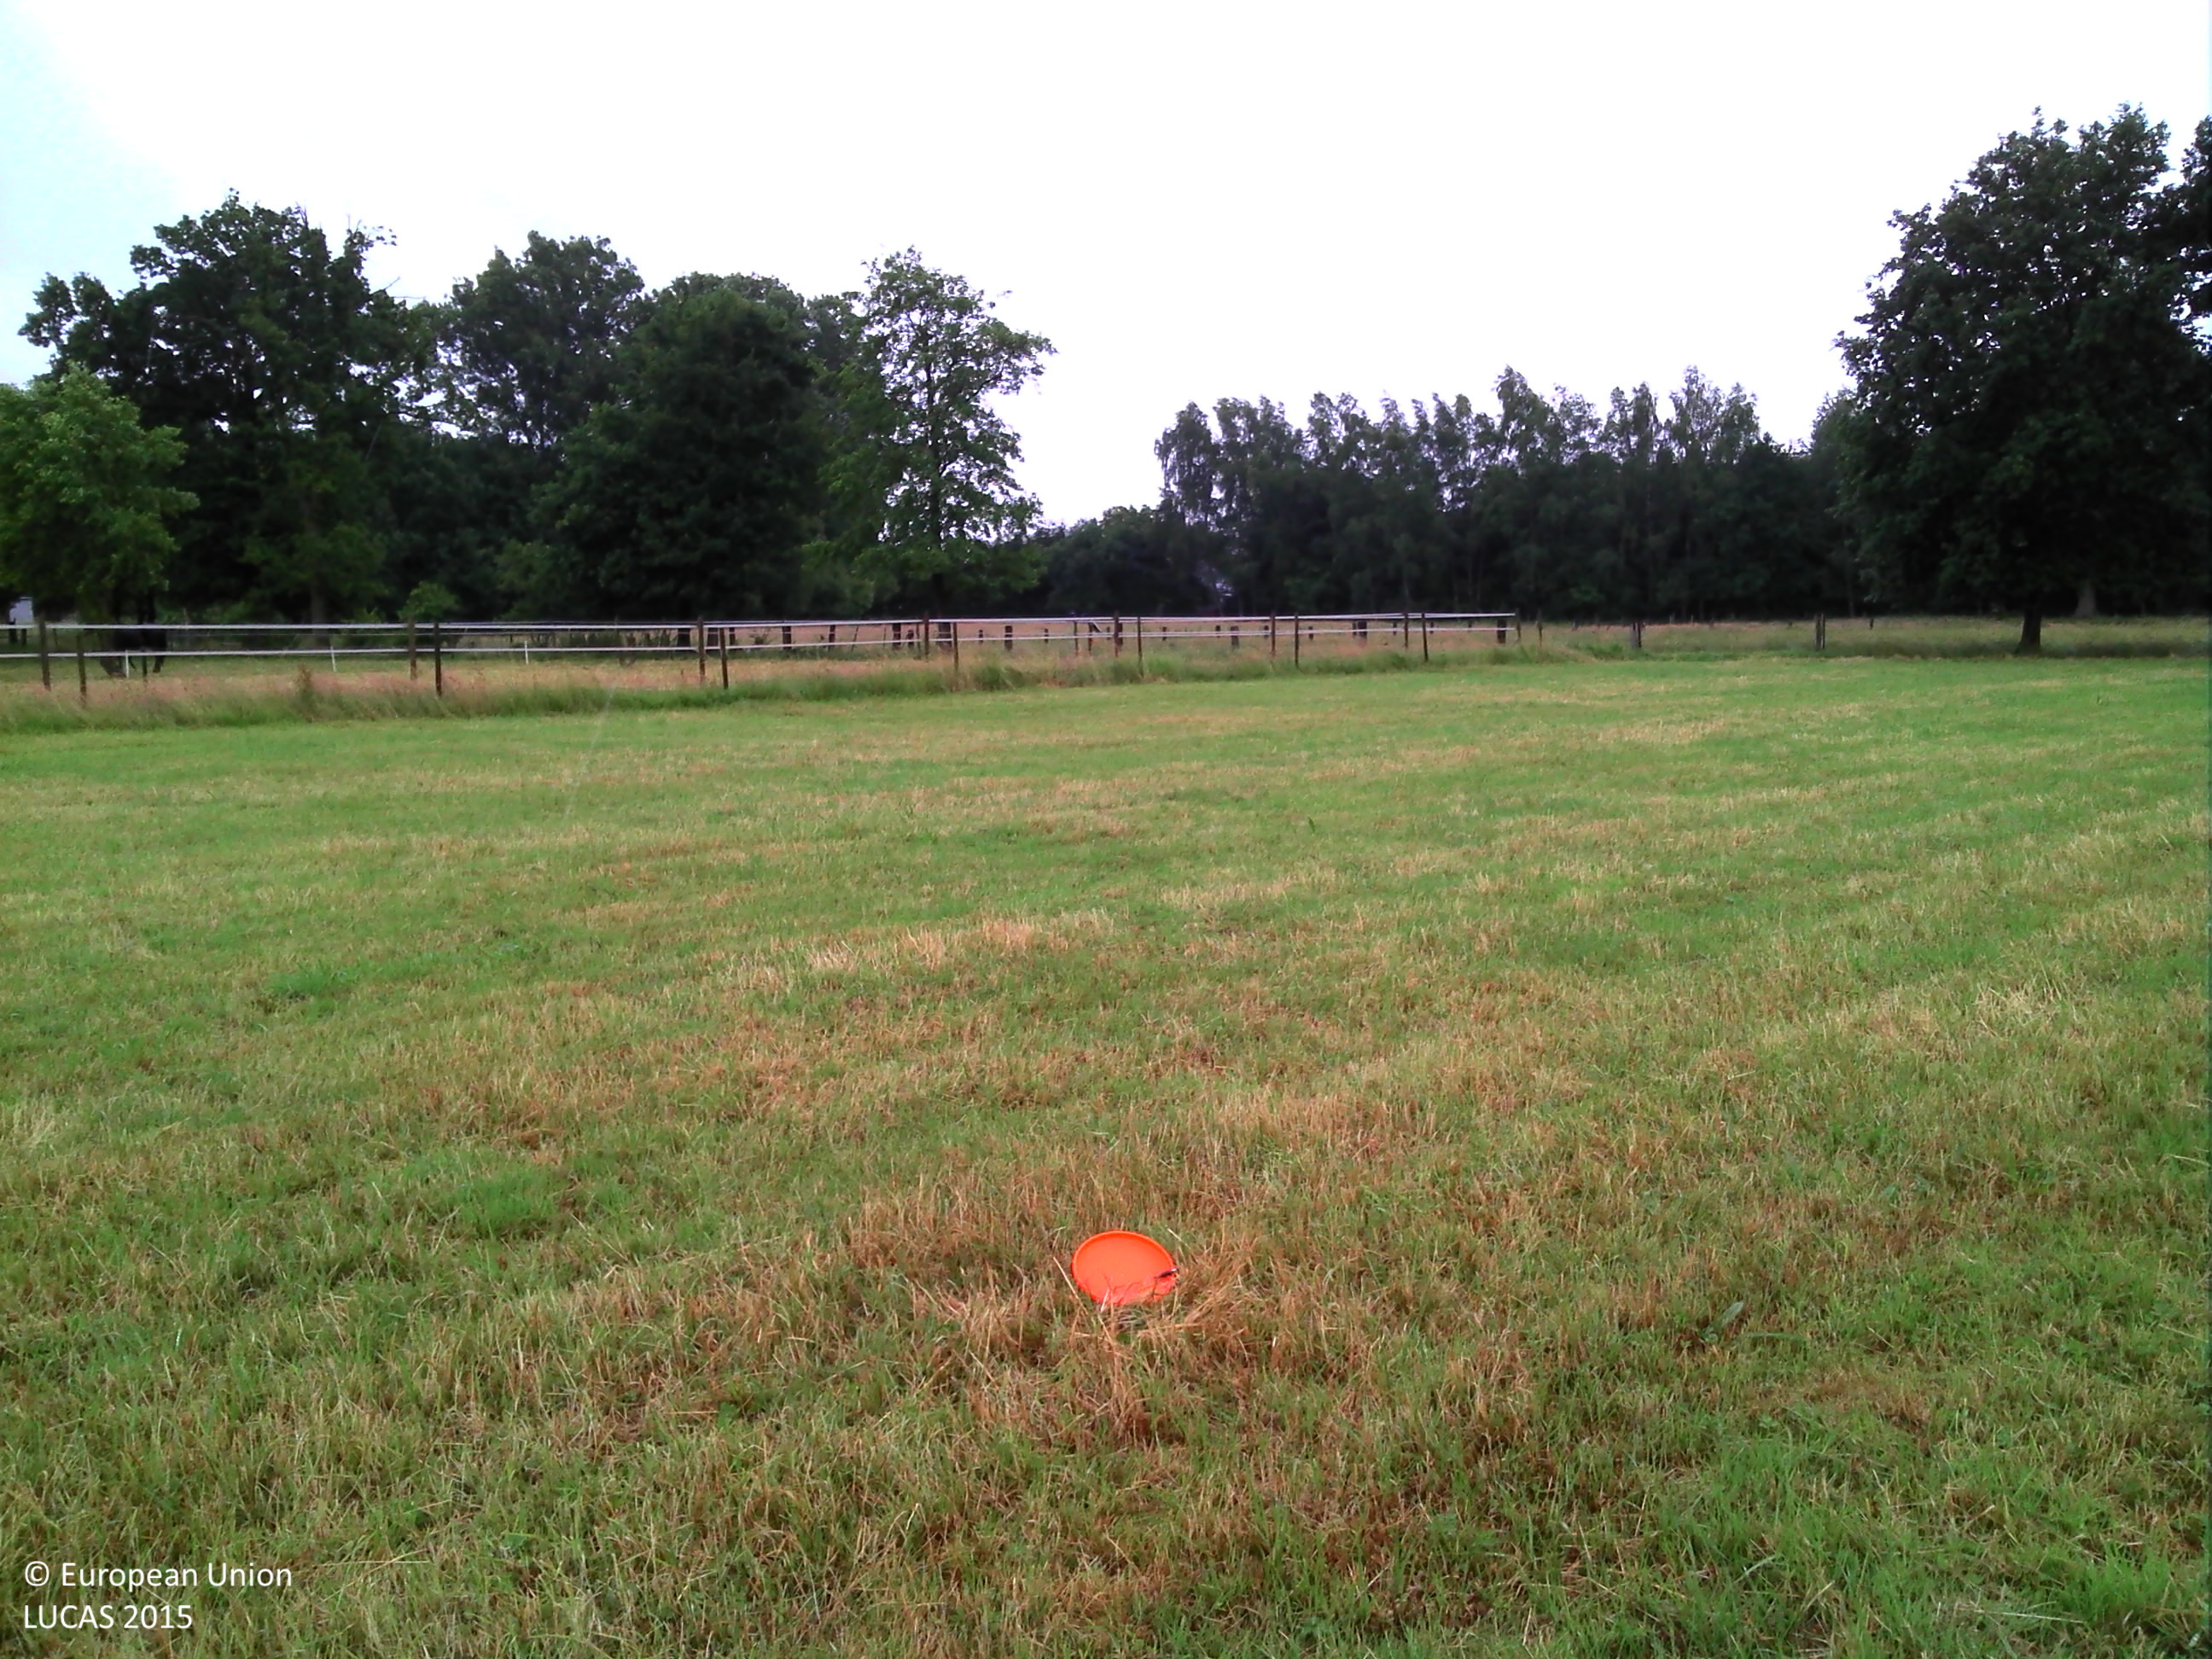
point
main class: Grassland
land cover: Grassland without tree/shrub cover
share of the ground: > 75 %
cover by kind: herbaceous plants 100 %
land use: Agriculture (excluding fallow land and kitchen gardens)
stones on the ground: < 10 %
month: June
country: BE
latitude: 51.0937
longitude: 5.2429
